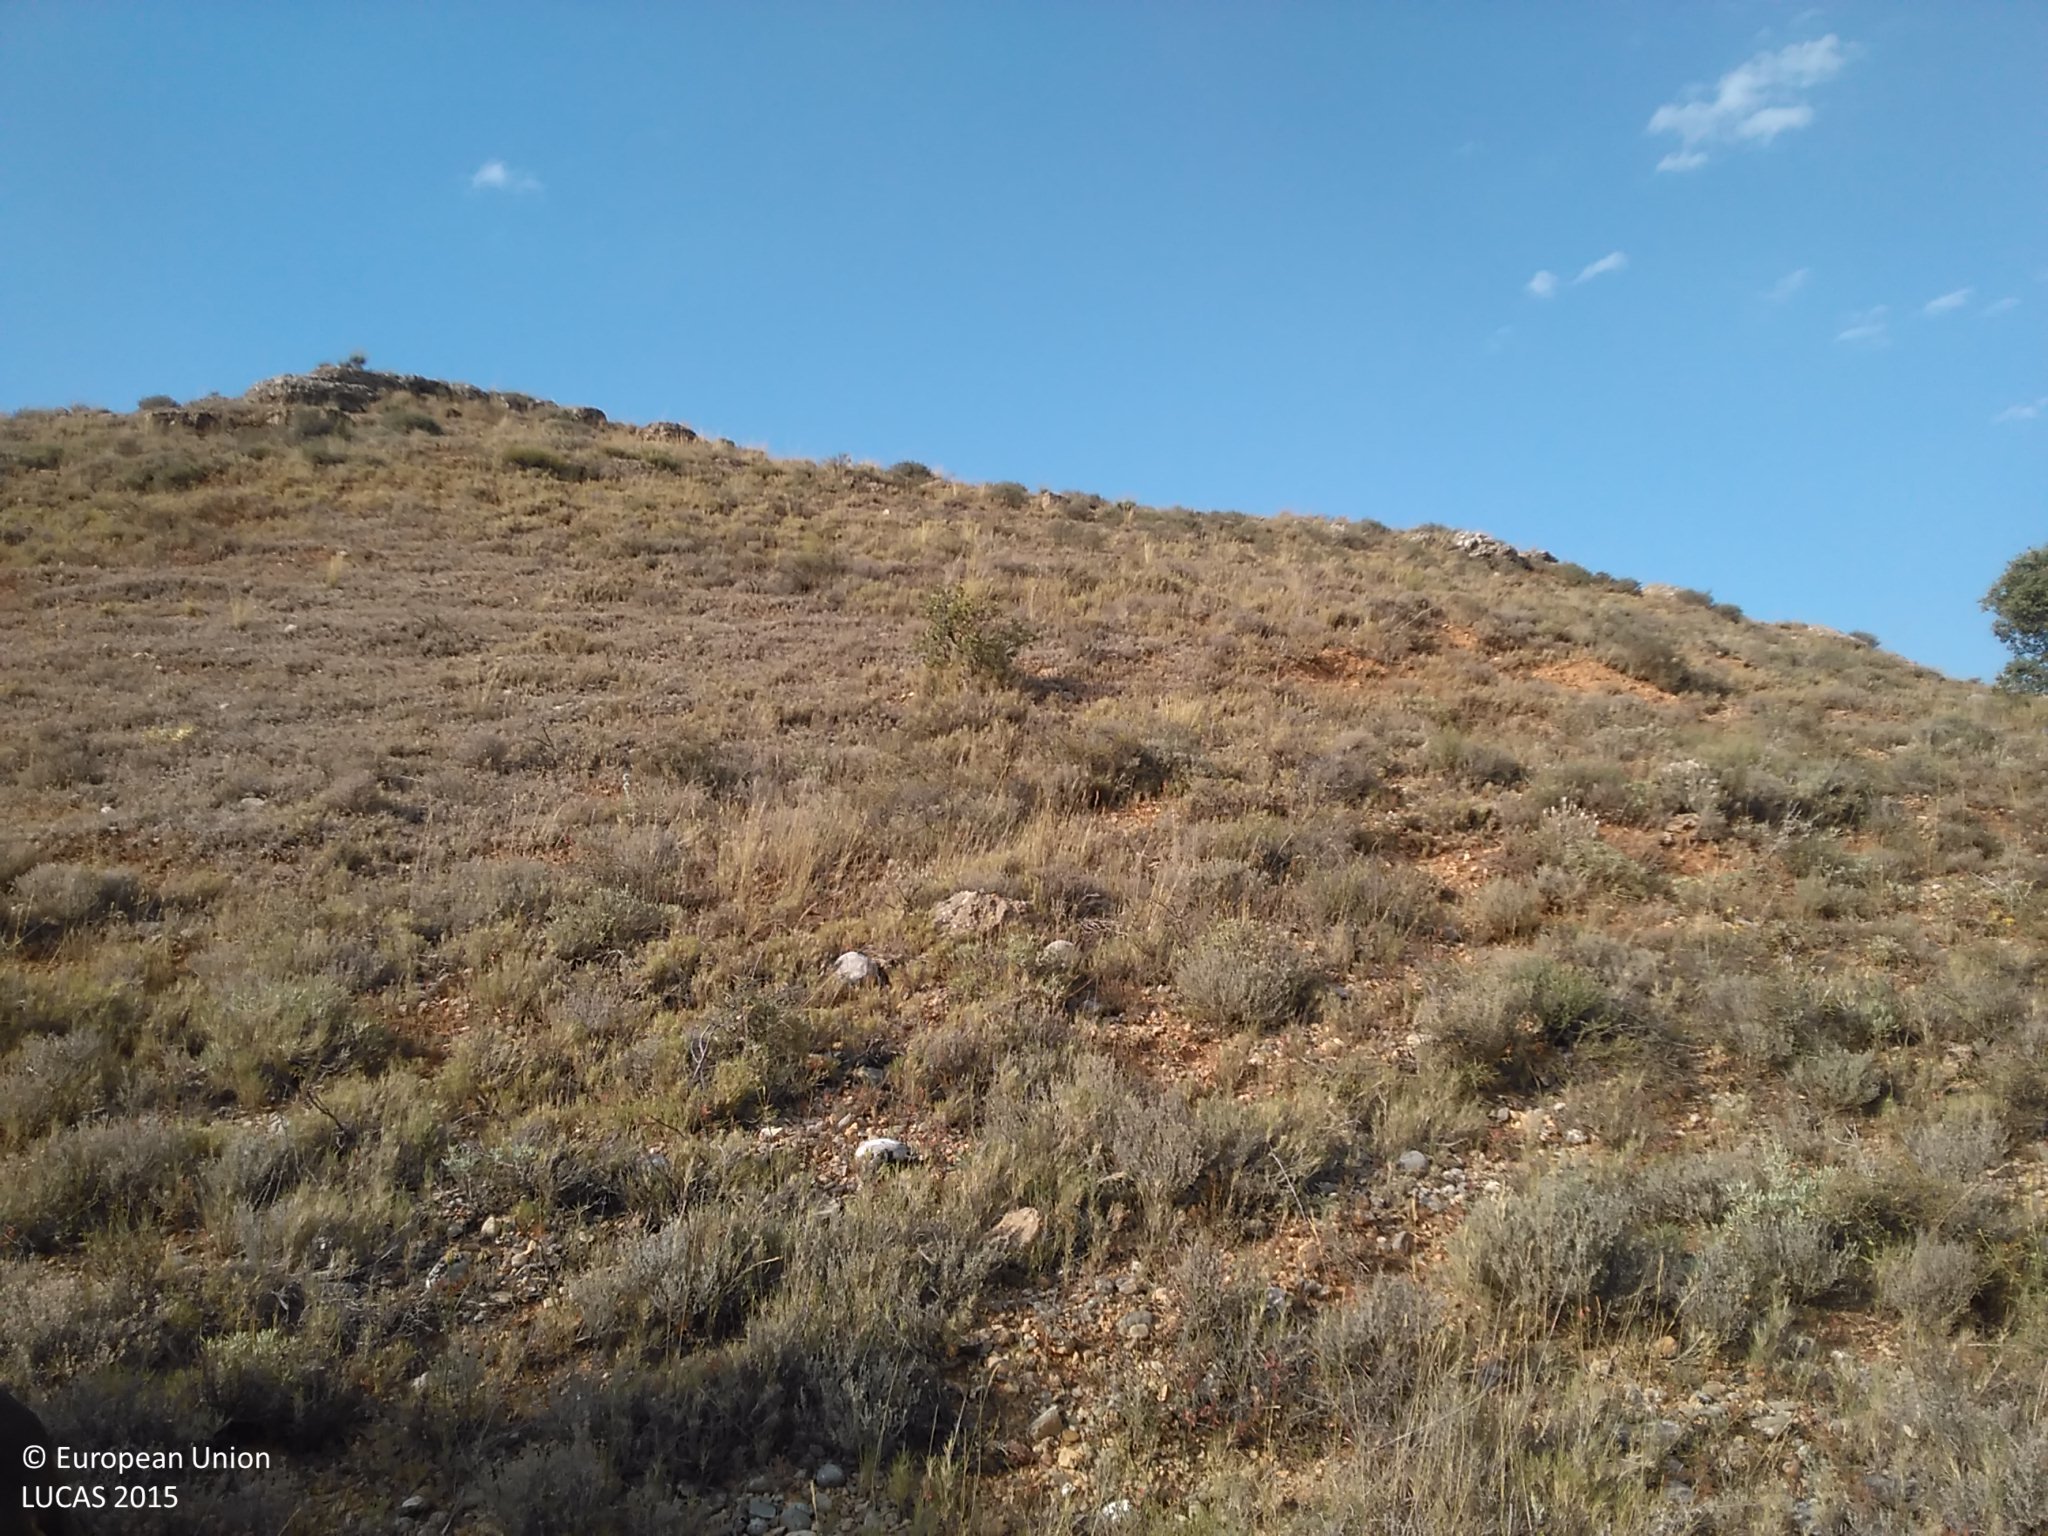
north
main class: Shrubland
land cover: Shrubland without tree cover
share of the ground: 50 - 75 %
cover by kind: shrubs 60 %, unconsolidated bare surface 30 %, herbaceous plants 10 %
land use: Semi-natural and natural areas not in use
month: July
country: ES
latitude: 41.4743
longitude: -2.2104
